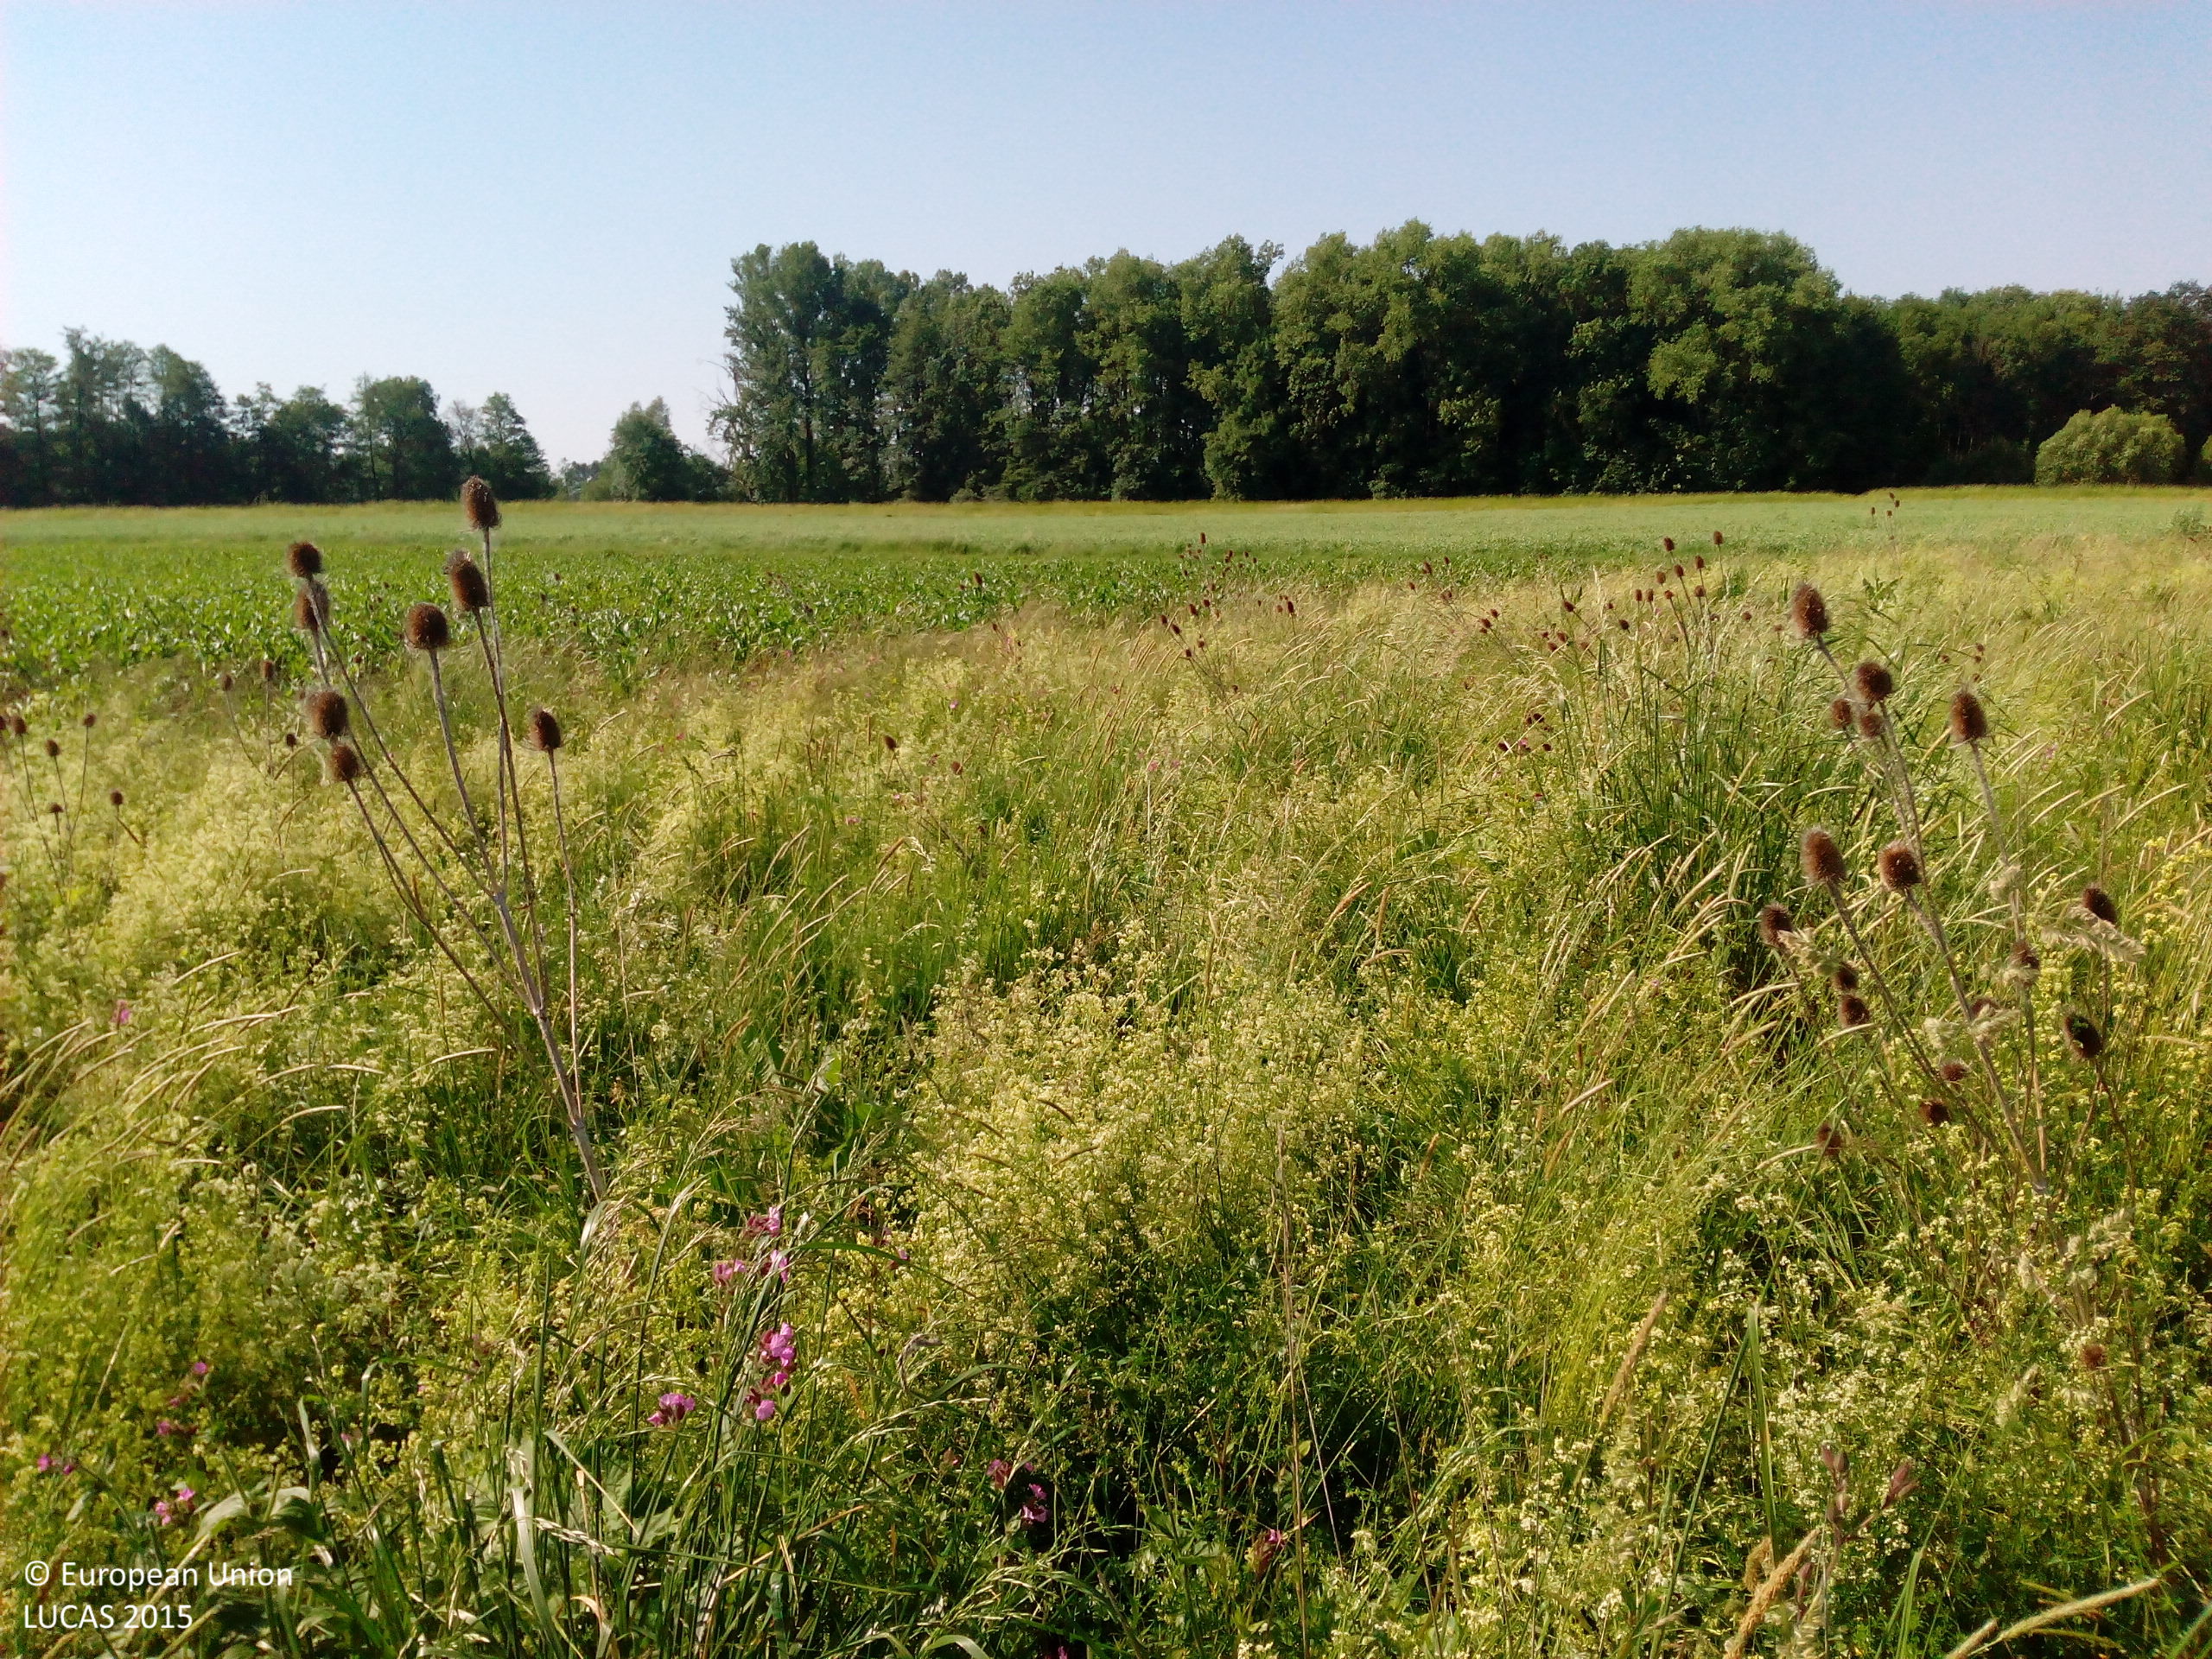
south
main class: Grassland
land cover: Spontaneously vegetated surfaces
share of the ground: > 75 %
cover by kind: herbaceous plants 100 %
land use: Fallow land
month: June
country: DE
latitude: 48.9171
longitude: 12.4147
